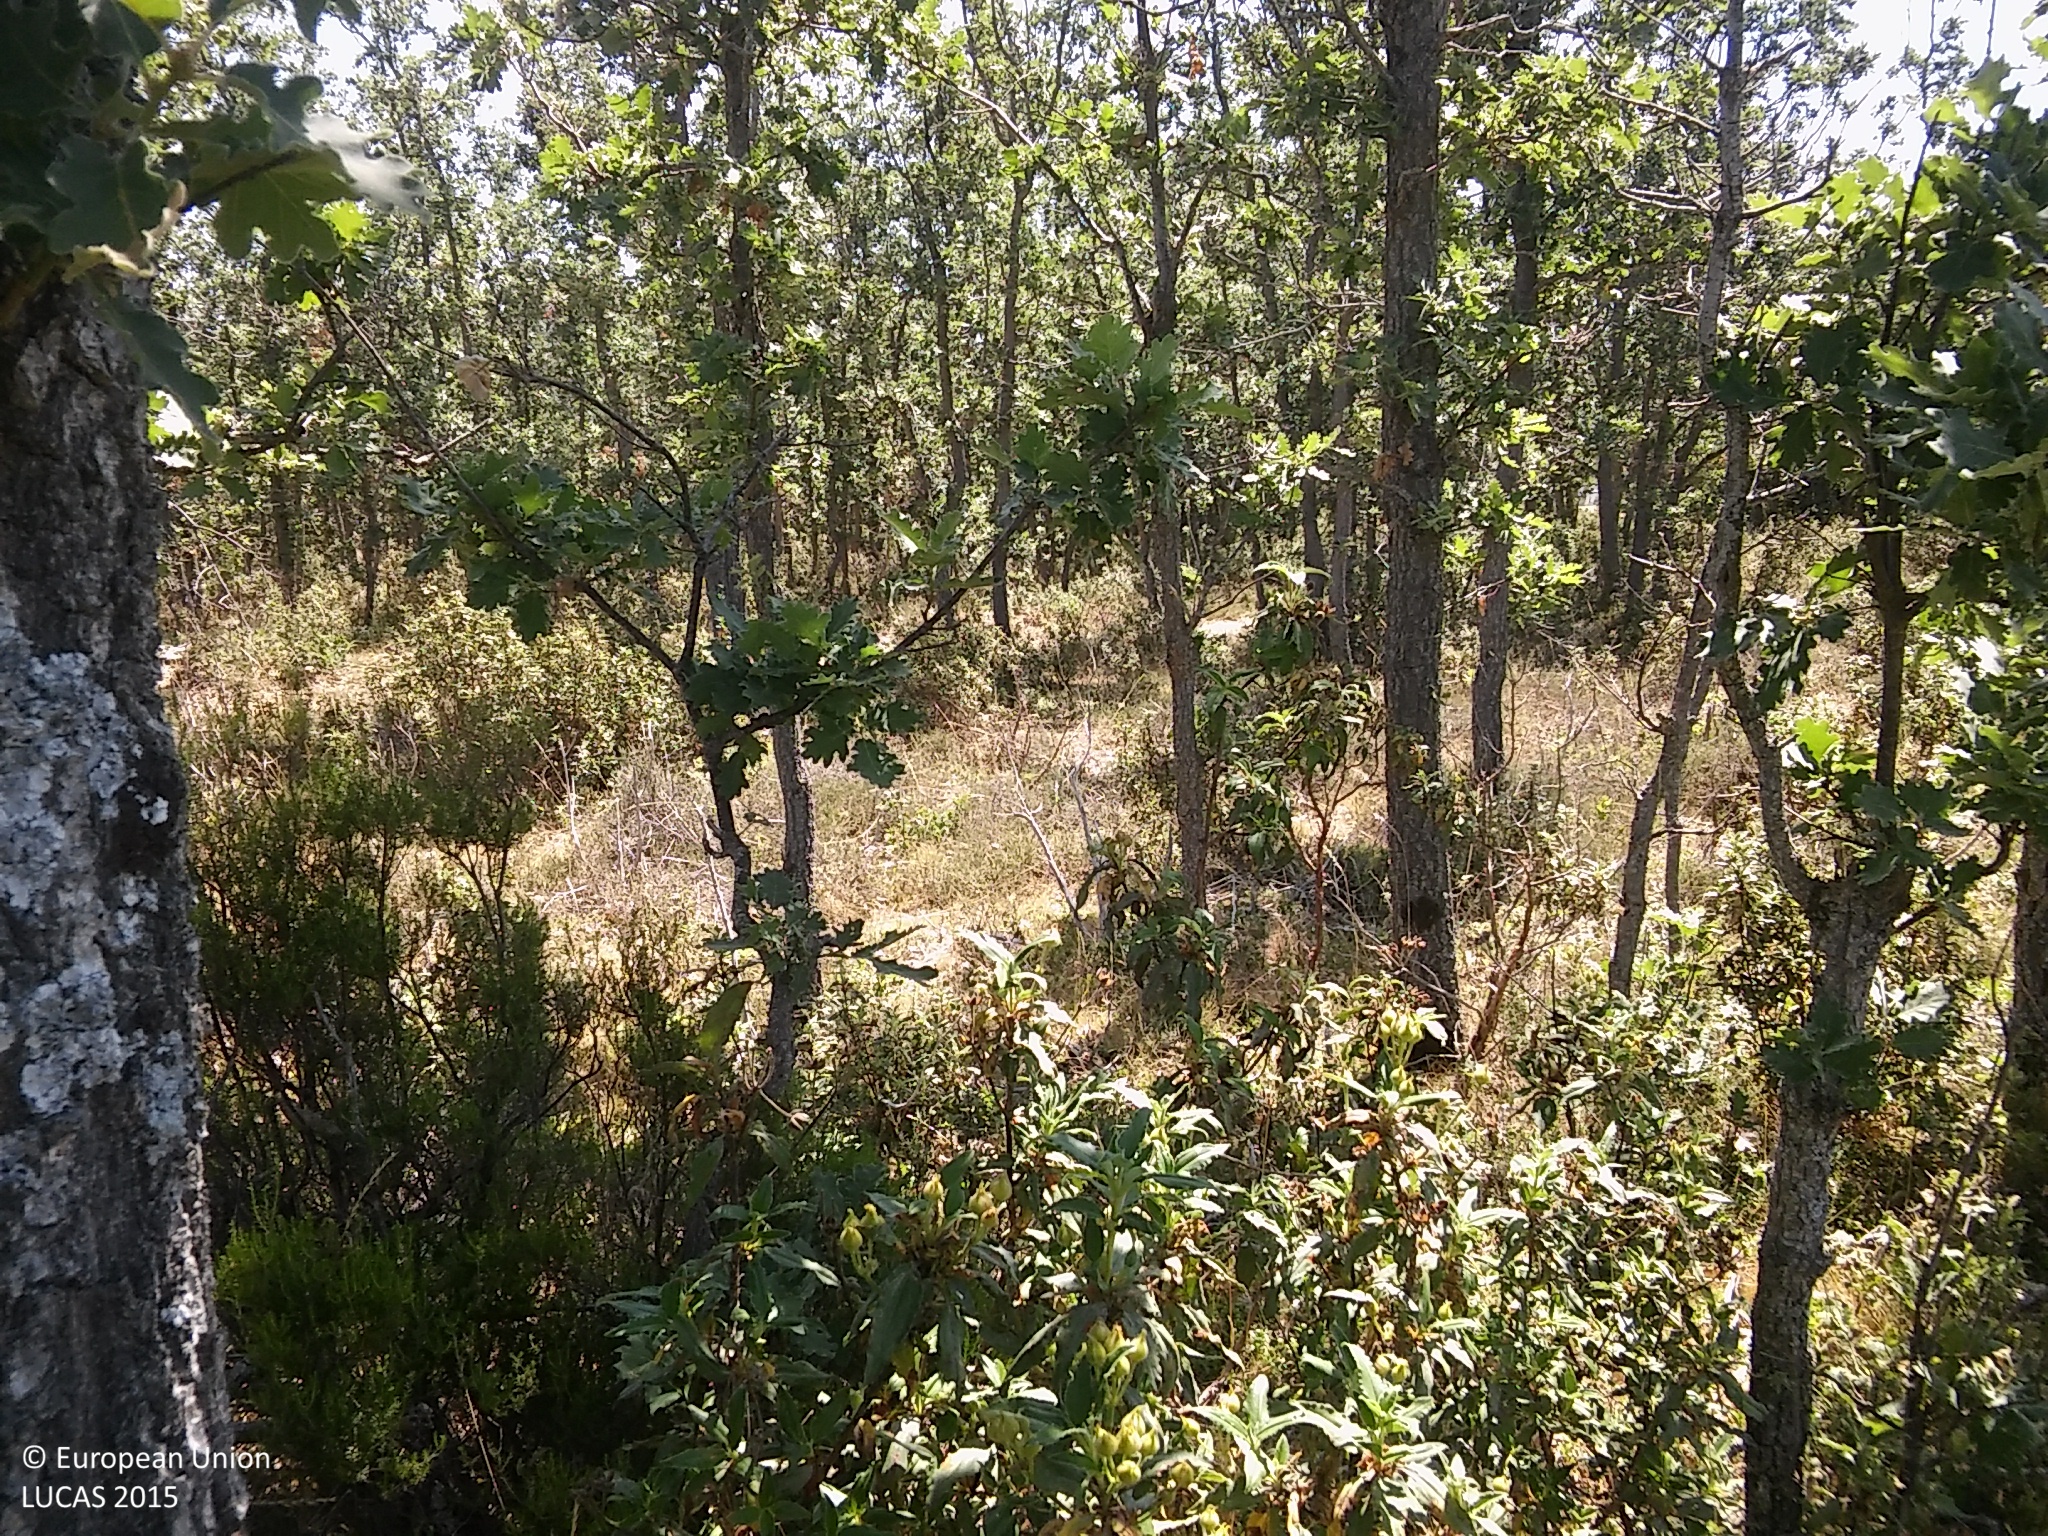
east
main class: Woodland
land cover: Broadleaved woodland
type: acidophilous oak and oak-birch forest
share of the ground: 25 - 50 %
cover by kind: shrubs 40 %, broadleaved forest trees 30 %, herbaceous plants 30 %
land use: Forestry
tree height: > 5 m
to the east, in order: Broadleaved woodland; Tracks; Broadleaved woodland; Tracks; Broadleaved woodland; Tracks; Grassland without tree/shrub cover; Tracks; Broadleaved woodland; Grassland without tree/shrub cover; Common wheat
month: July
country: ES
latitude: 41.2880
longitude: -3.5027
